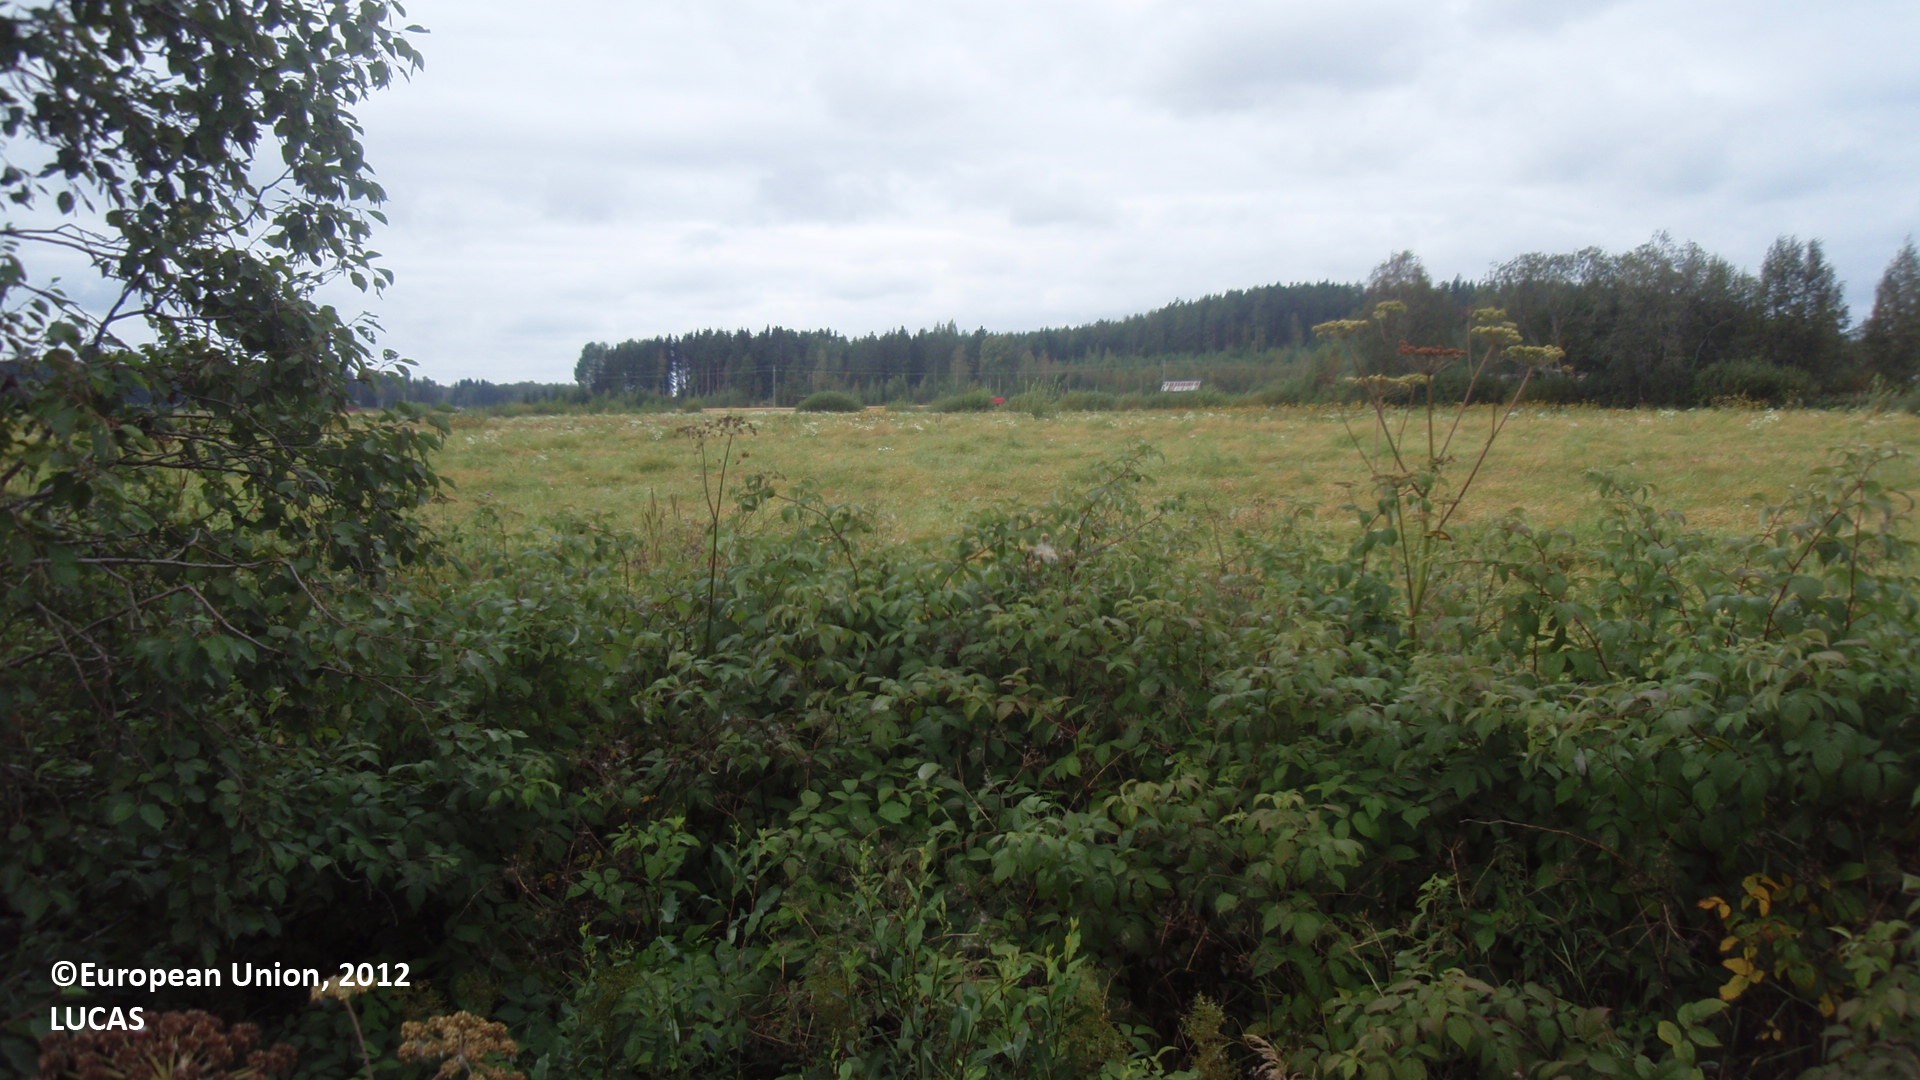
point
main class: Cropland
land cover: Mixed cereals for fodder
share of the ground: > 75 %
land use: Agriculture (excluding fallow land and kitchen gardens)
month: August
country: FI
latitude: 61.0411
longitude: 26.6907
